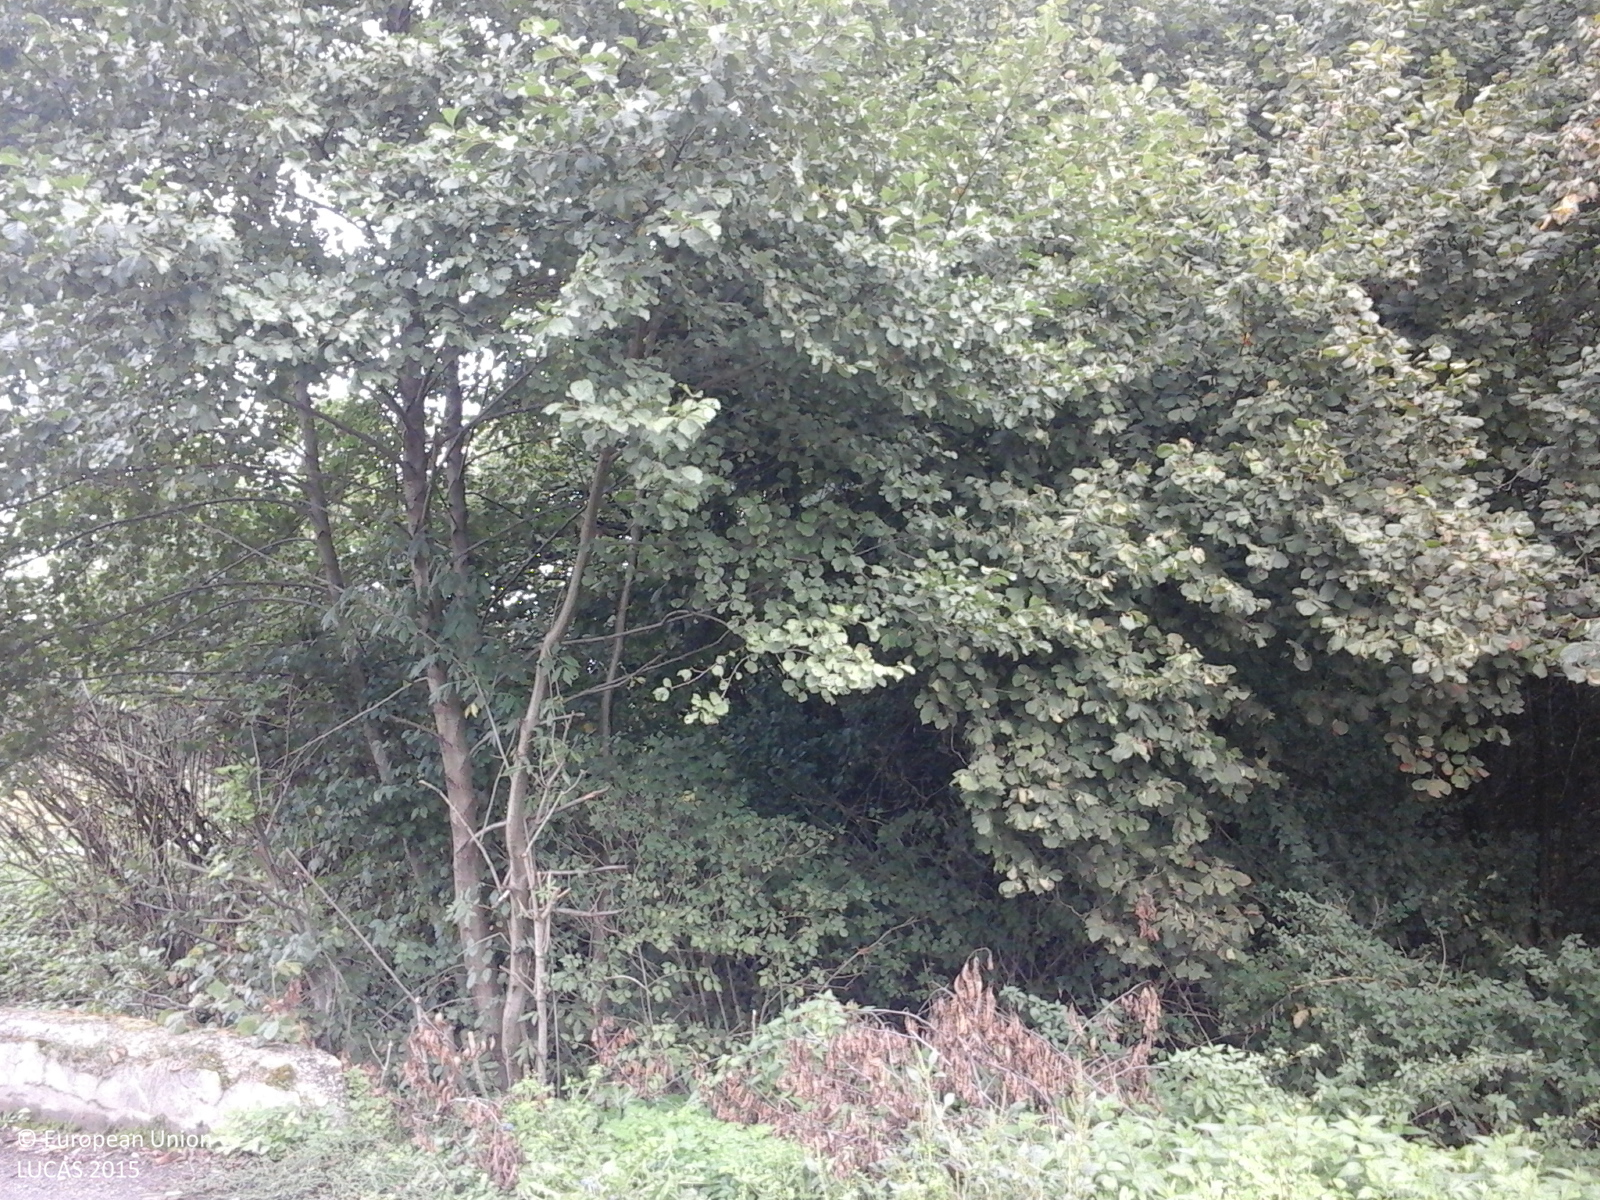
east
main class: Shrubland
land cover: Shrubland with sparse tree cover
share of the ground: > 75 %
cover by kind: shrubs 95 %, broadleaved forest trees 5 %
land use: Semi-natural and natural areas not in use
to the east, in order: Shrubland with sparse tree cover; Paved roads, cycling and walking lanes; Broadleaved woodland; Paved roads, cycling and walking lanes; Abandoned hedges; Grassland without tree/shrub cover; Maize; Fences; Other fruit trees and berries; Artificial constructions in urban areas
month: September
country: RO
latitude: 45.9138
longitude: 22.2797
